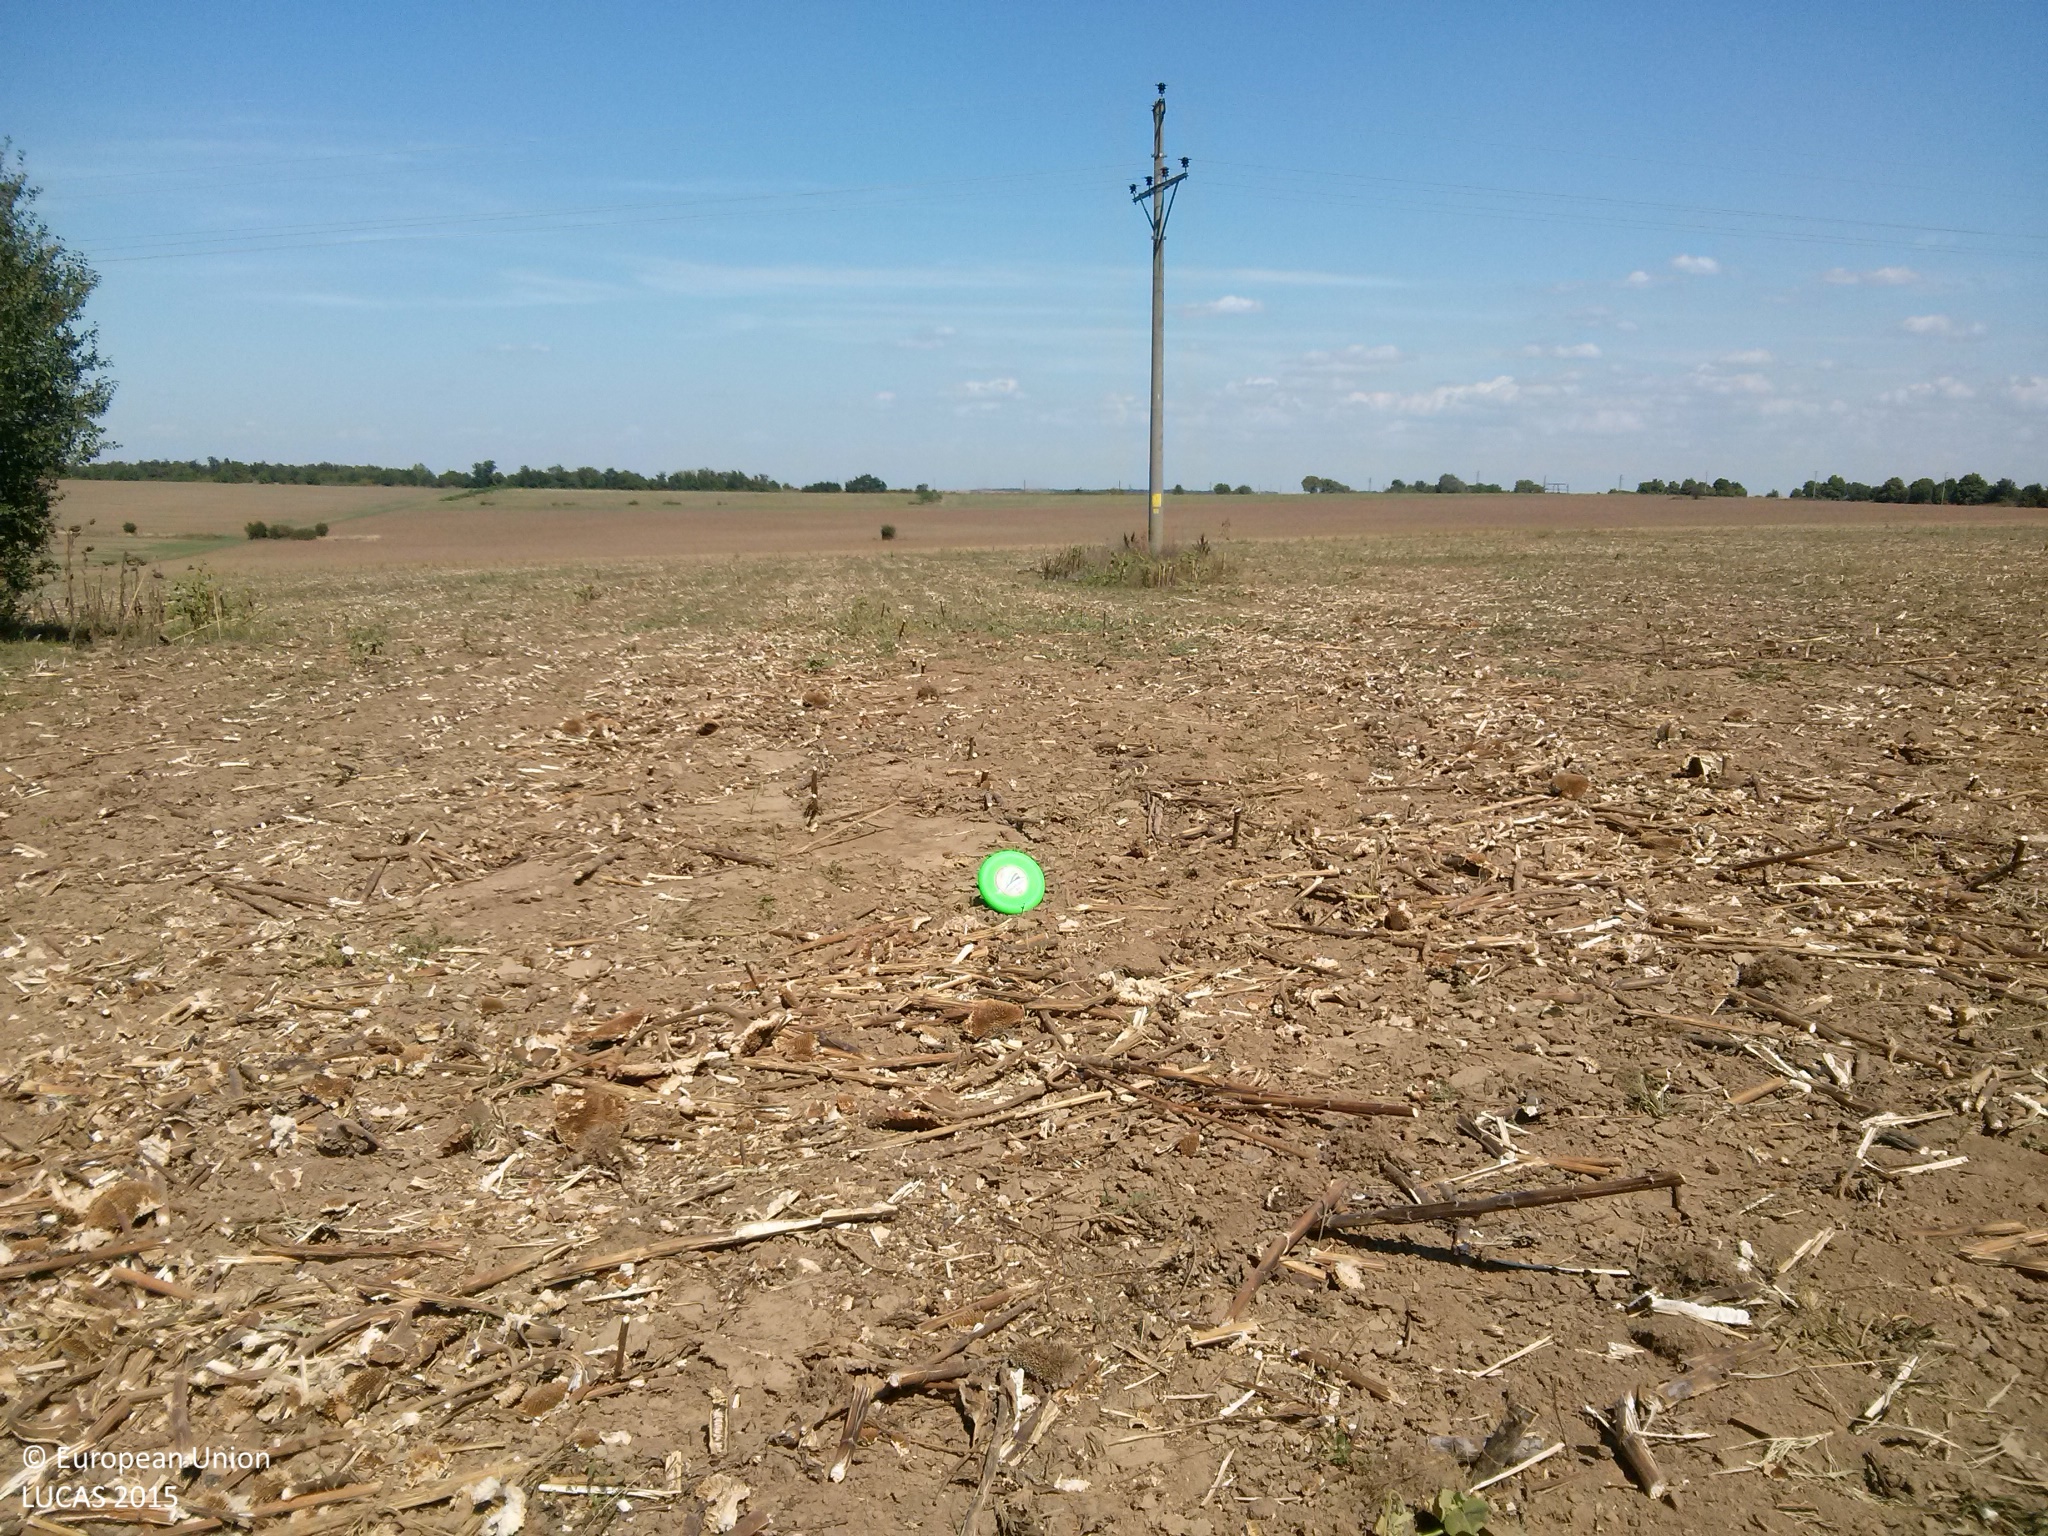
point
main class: Cropland
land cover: Sunflower
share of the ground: < 10 %
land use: Agriculture (excluding fallow land and kitchen gardens)
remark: Harvested field
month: September
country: BG
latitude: 43.6699
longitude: 26.3372
